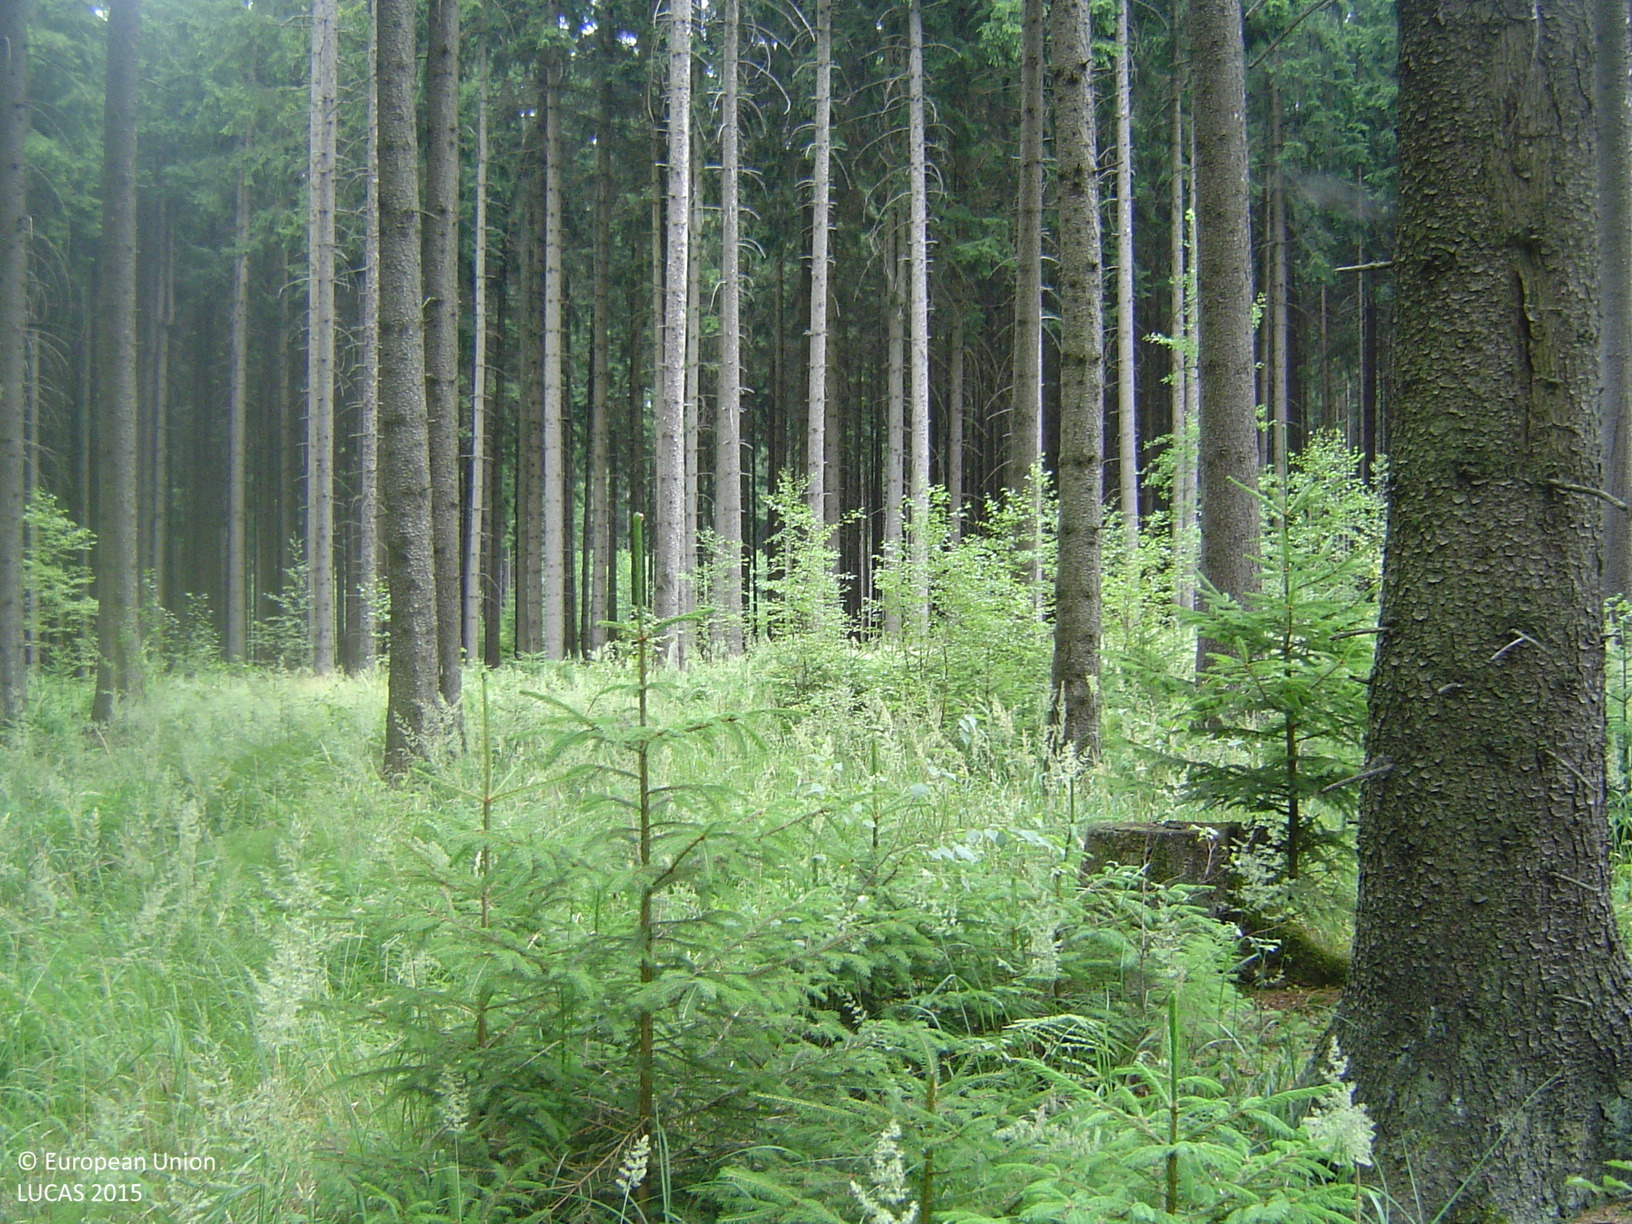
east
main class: Woodland
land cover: Spruce dominated coniferous woodland
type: hemiboreal forest and nemoral coniferous forest and mixed broadleaved-coniferous forest
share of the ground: > 75 %
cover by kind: coniferous forest trees 90 %, broadleaved forest trees 5 %, herbaceous plants 5 %
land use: Forestry
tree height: > 5 m
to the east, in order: Spruce dominated coniferous woodland
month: July
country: CZ
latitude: 49.2178
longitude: 15.5915
